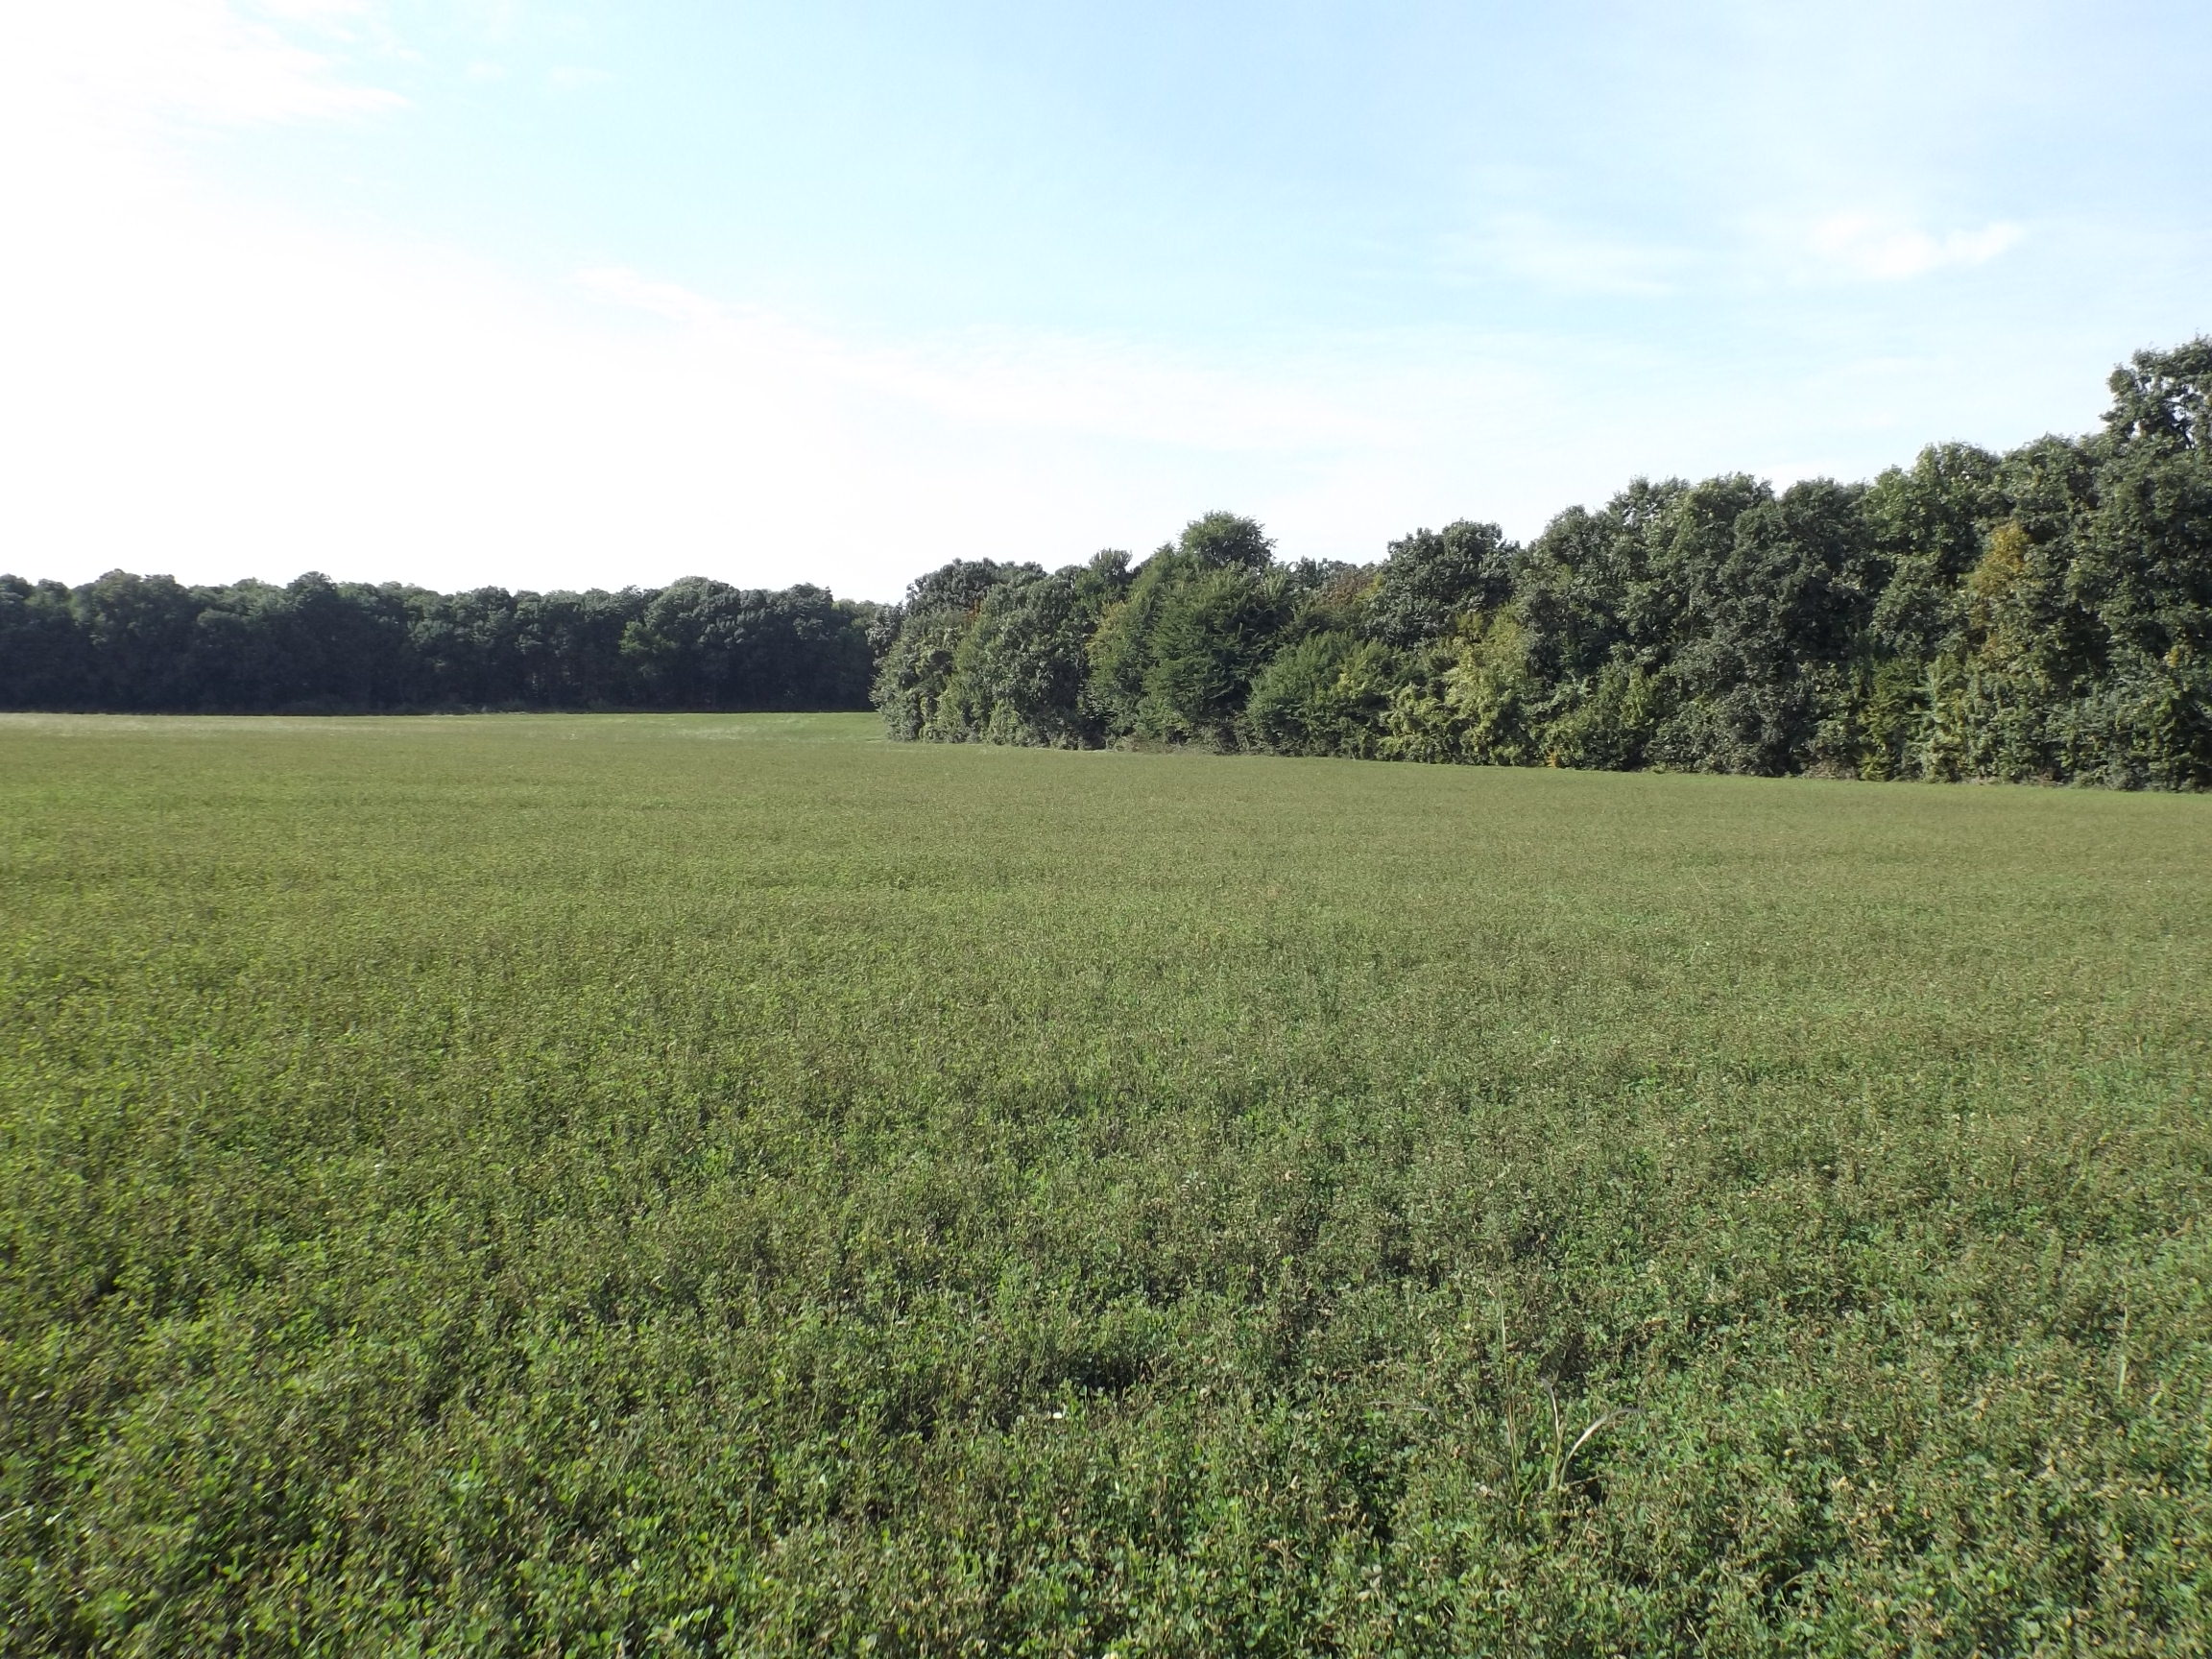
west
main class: Cropland
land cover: Lucerne
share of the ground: > 75 %
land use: Agriculture (excluding fallow land and kitchen gardens)
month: October
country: BG
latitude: 43.8736
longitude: 26.7792
